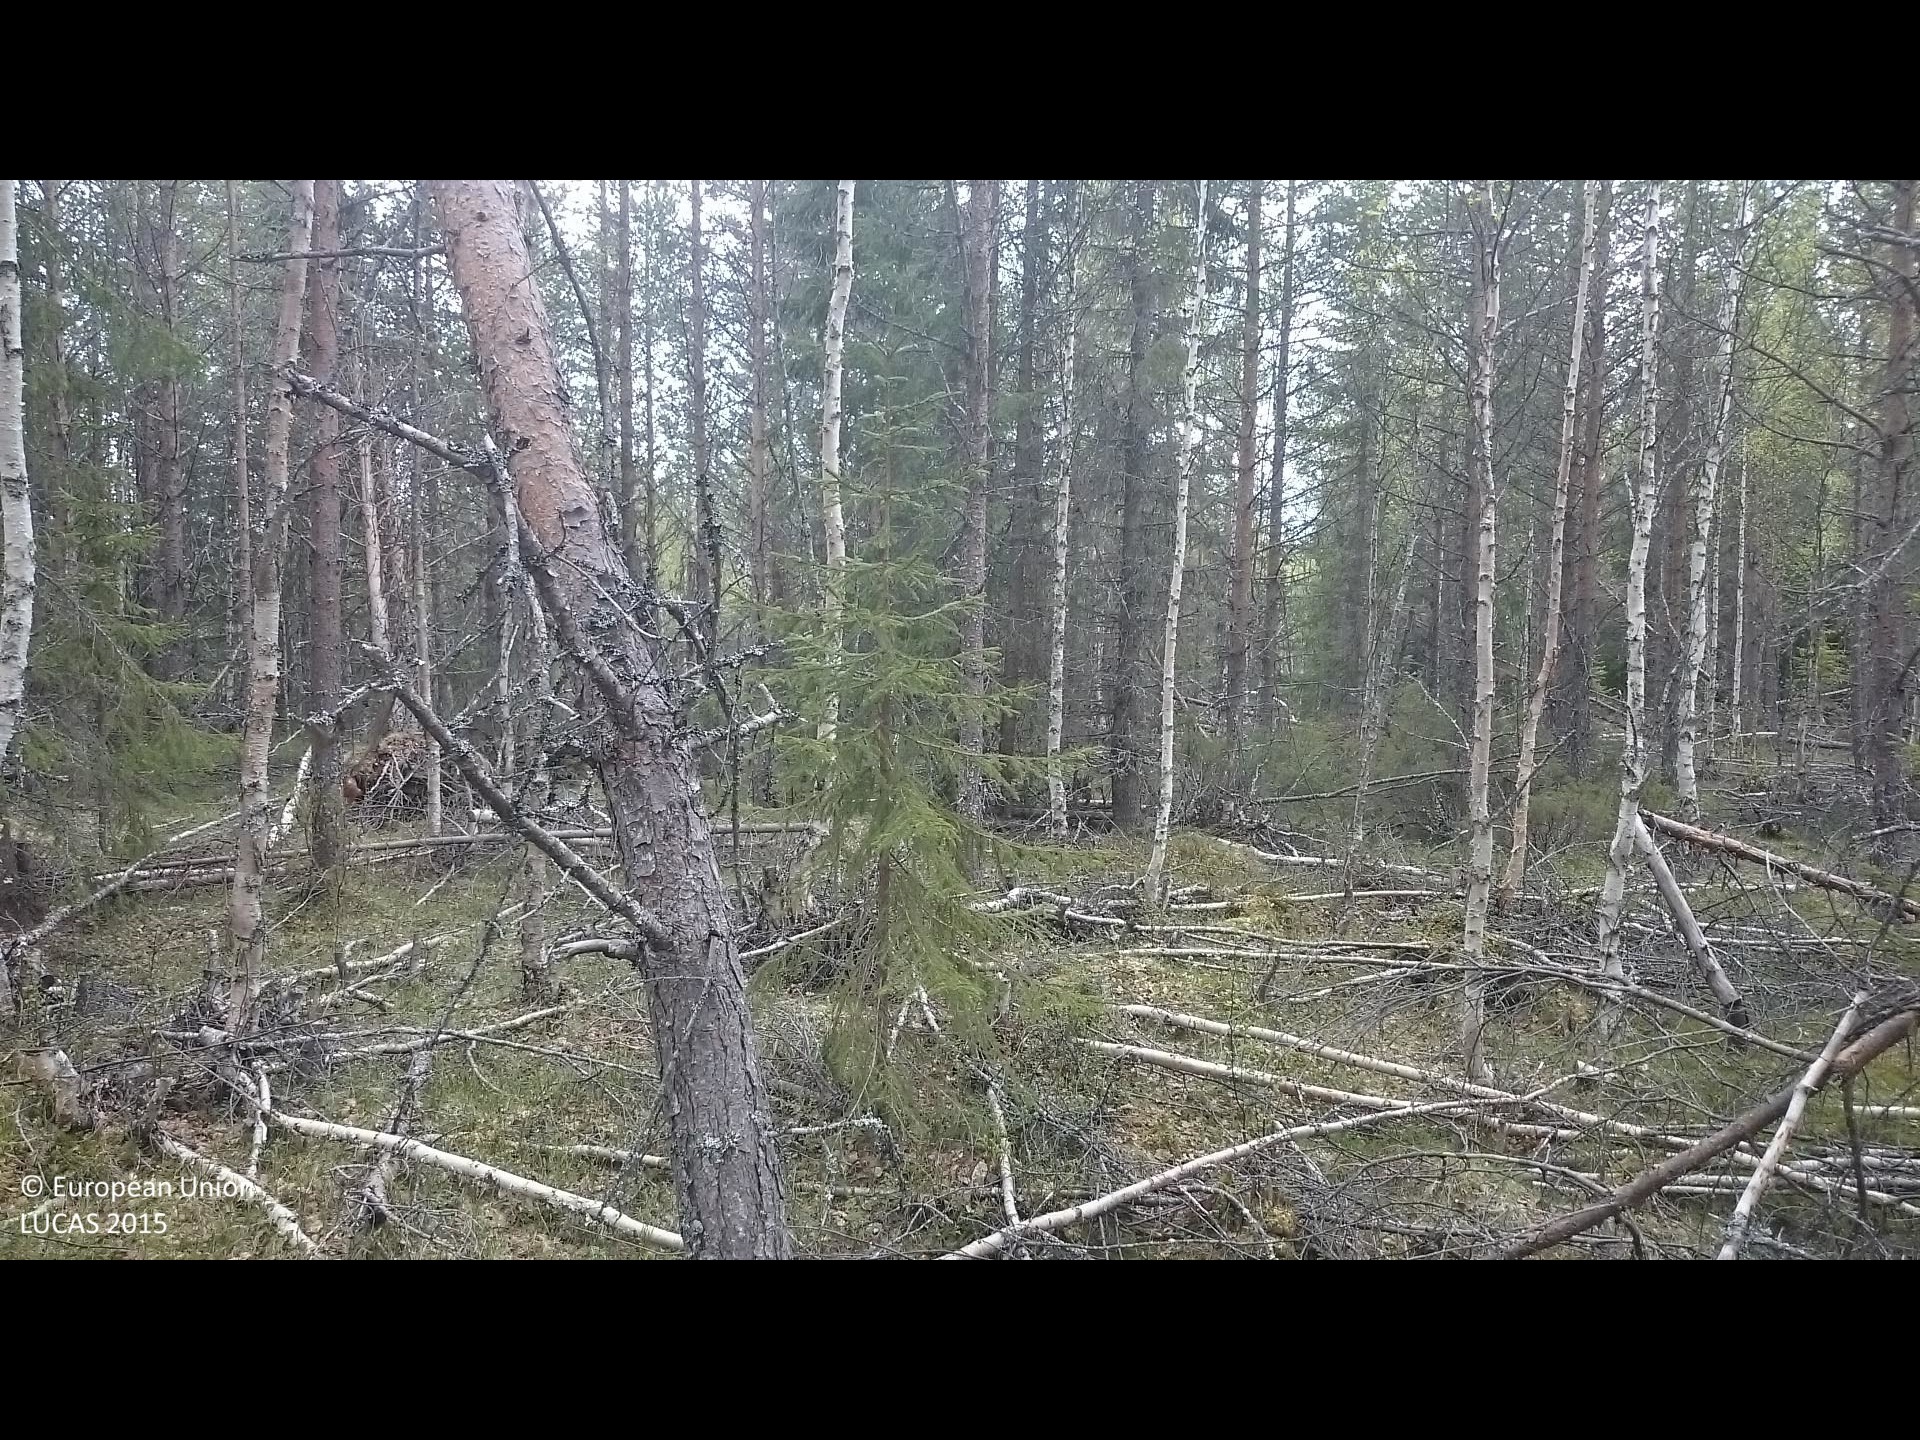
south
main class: Woodland
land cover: Pine dominated mixed woodland
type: boreal forest
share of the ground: > 75 %
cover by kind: coniferous forest trees 60 %, broadleaved forest trees 20 %, shrubs 10 %, herbaceous plants 10 %
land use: Forestry
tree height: > 5 m
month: June
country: SE
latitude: 63.5739
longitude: 13.8669
